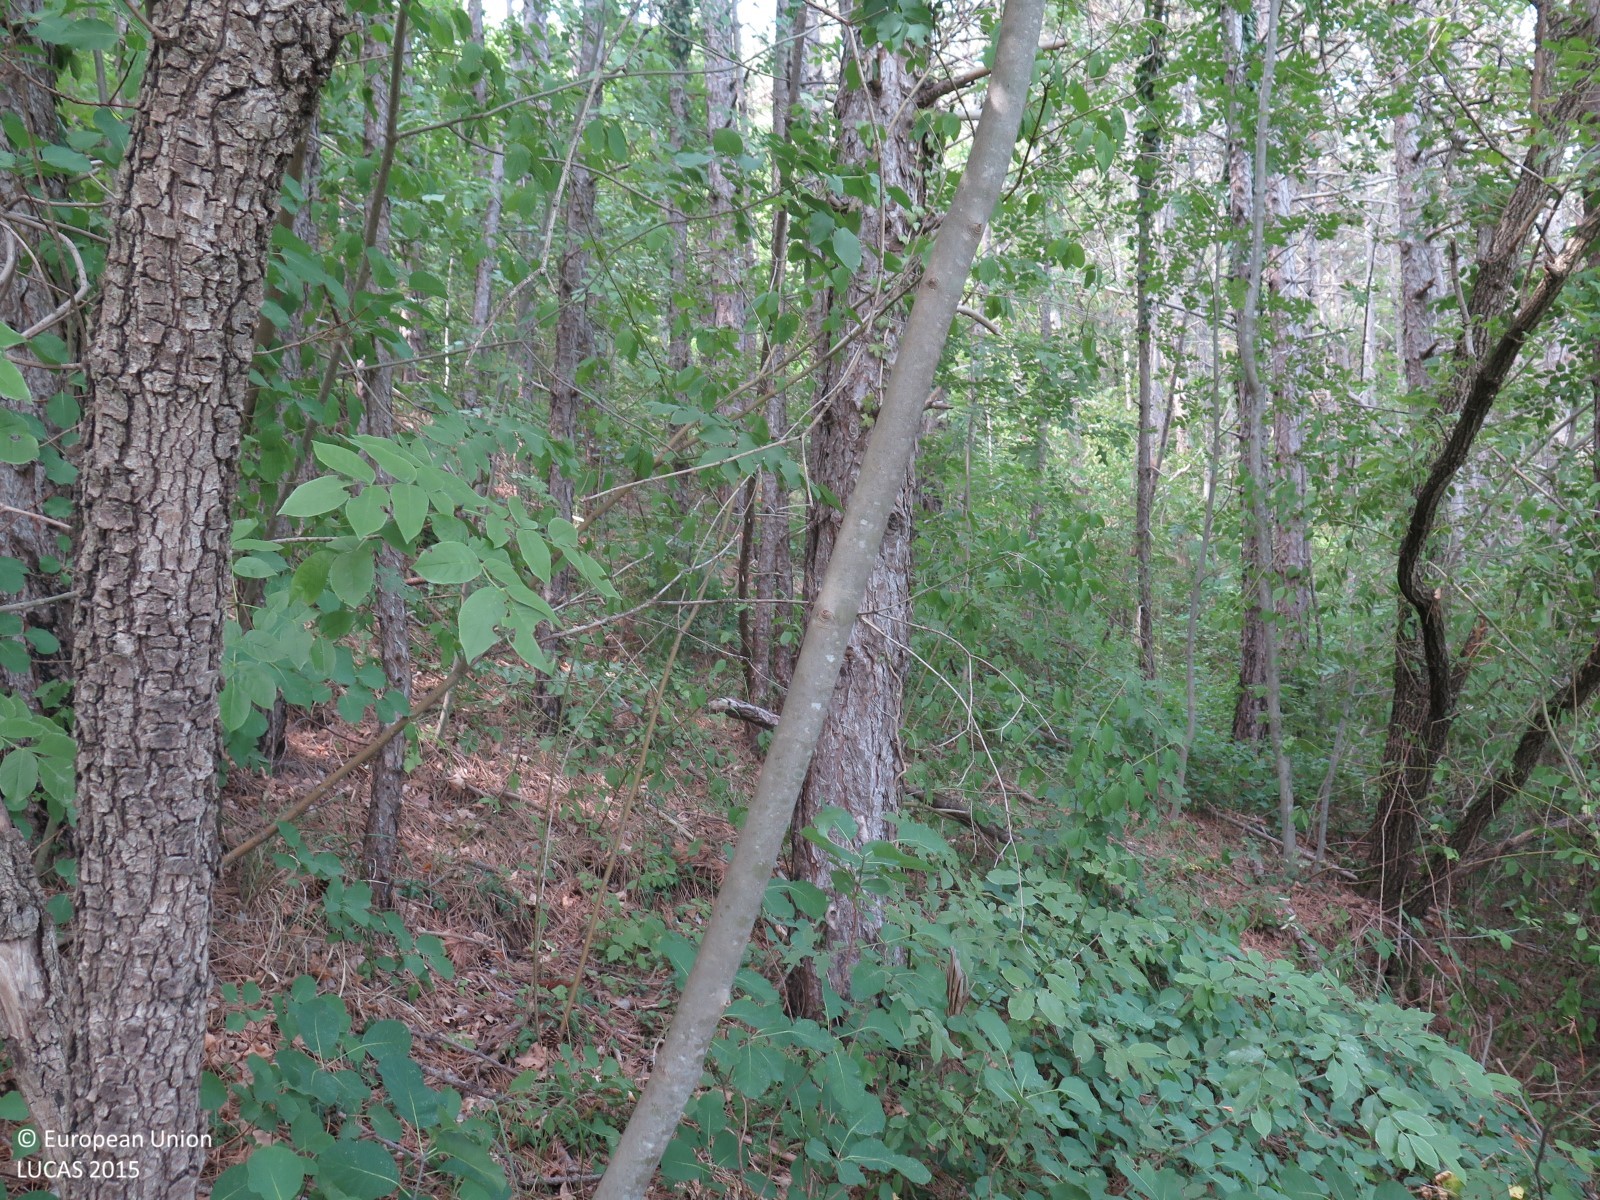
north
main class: Woodland
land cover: Pine dominated mixed woodland
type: coniferous forest of the mediterranean region
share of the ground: > 75 %
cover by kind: coniferous forest trees 75 %, broadleaved forest trees 25 %
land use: Semi-natural and natural areas not in use
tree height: > 5 m
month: July
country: HR
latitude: 45.2819
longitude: 14.0616
